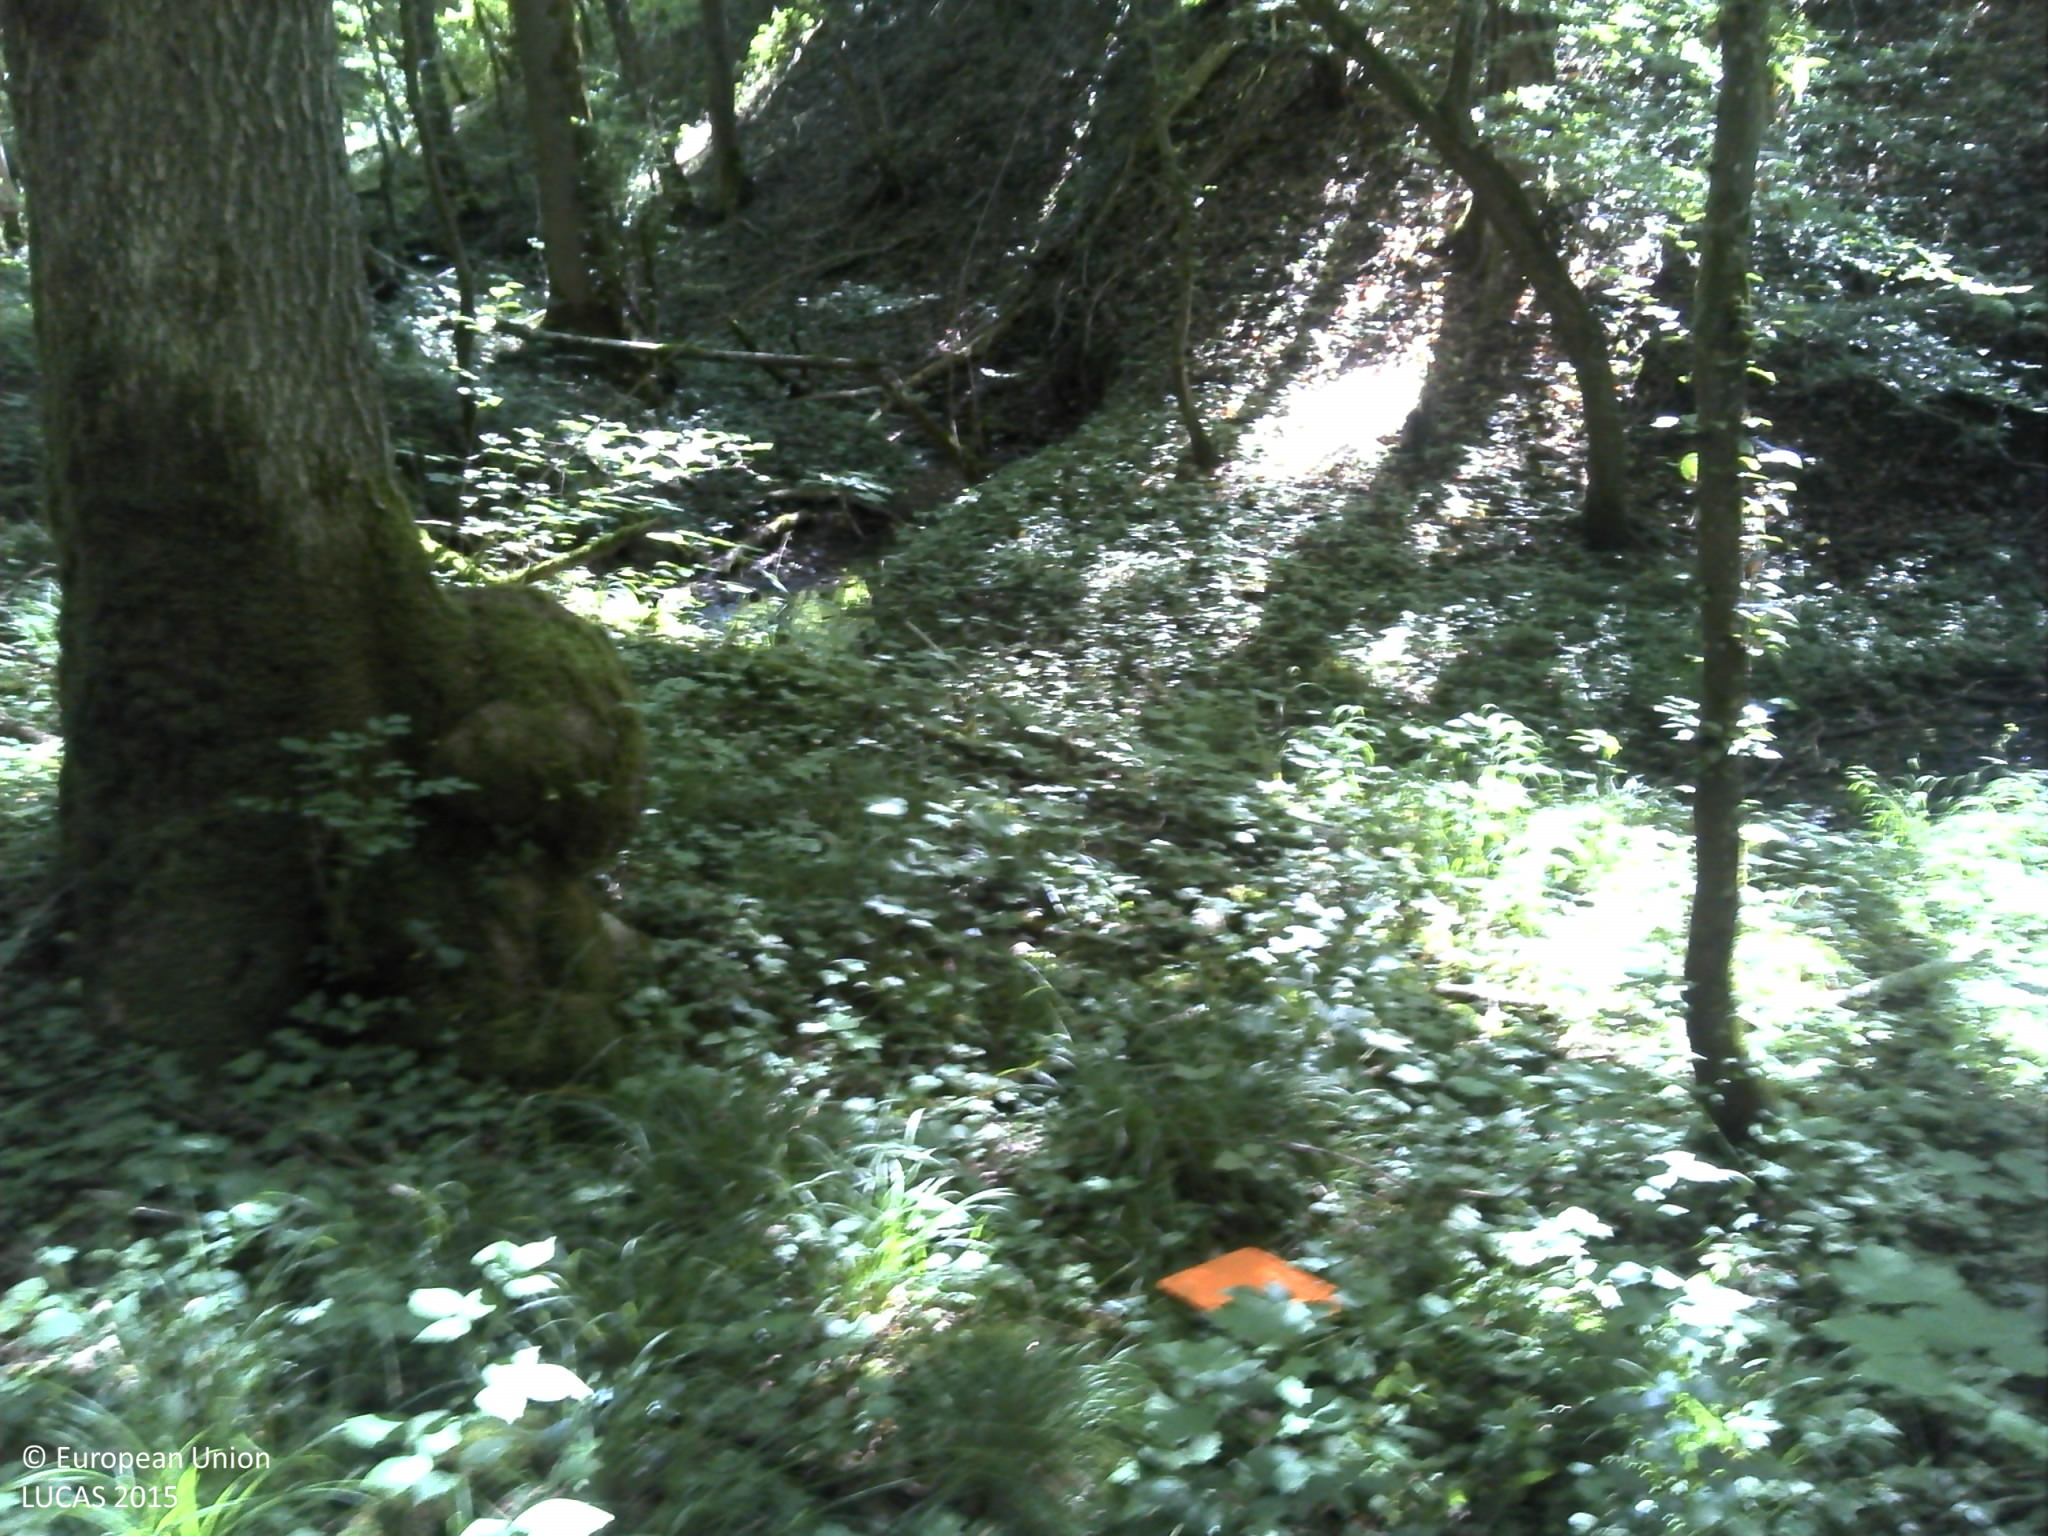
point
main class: Woodland
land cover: Broadleaved woodland
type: beech forest
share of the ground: > 75 %
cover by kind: broadleaved forest trees 70 %, herbaceous plants 20 %, lichens and mosses 5 %, consolidated bare surface 5 %
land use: Forestry
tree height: < 5 m
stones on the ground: < 10 %
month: July
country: FR
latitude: 49.6077
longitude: 4.6411
